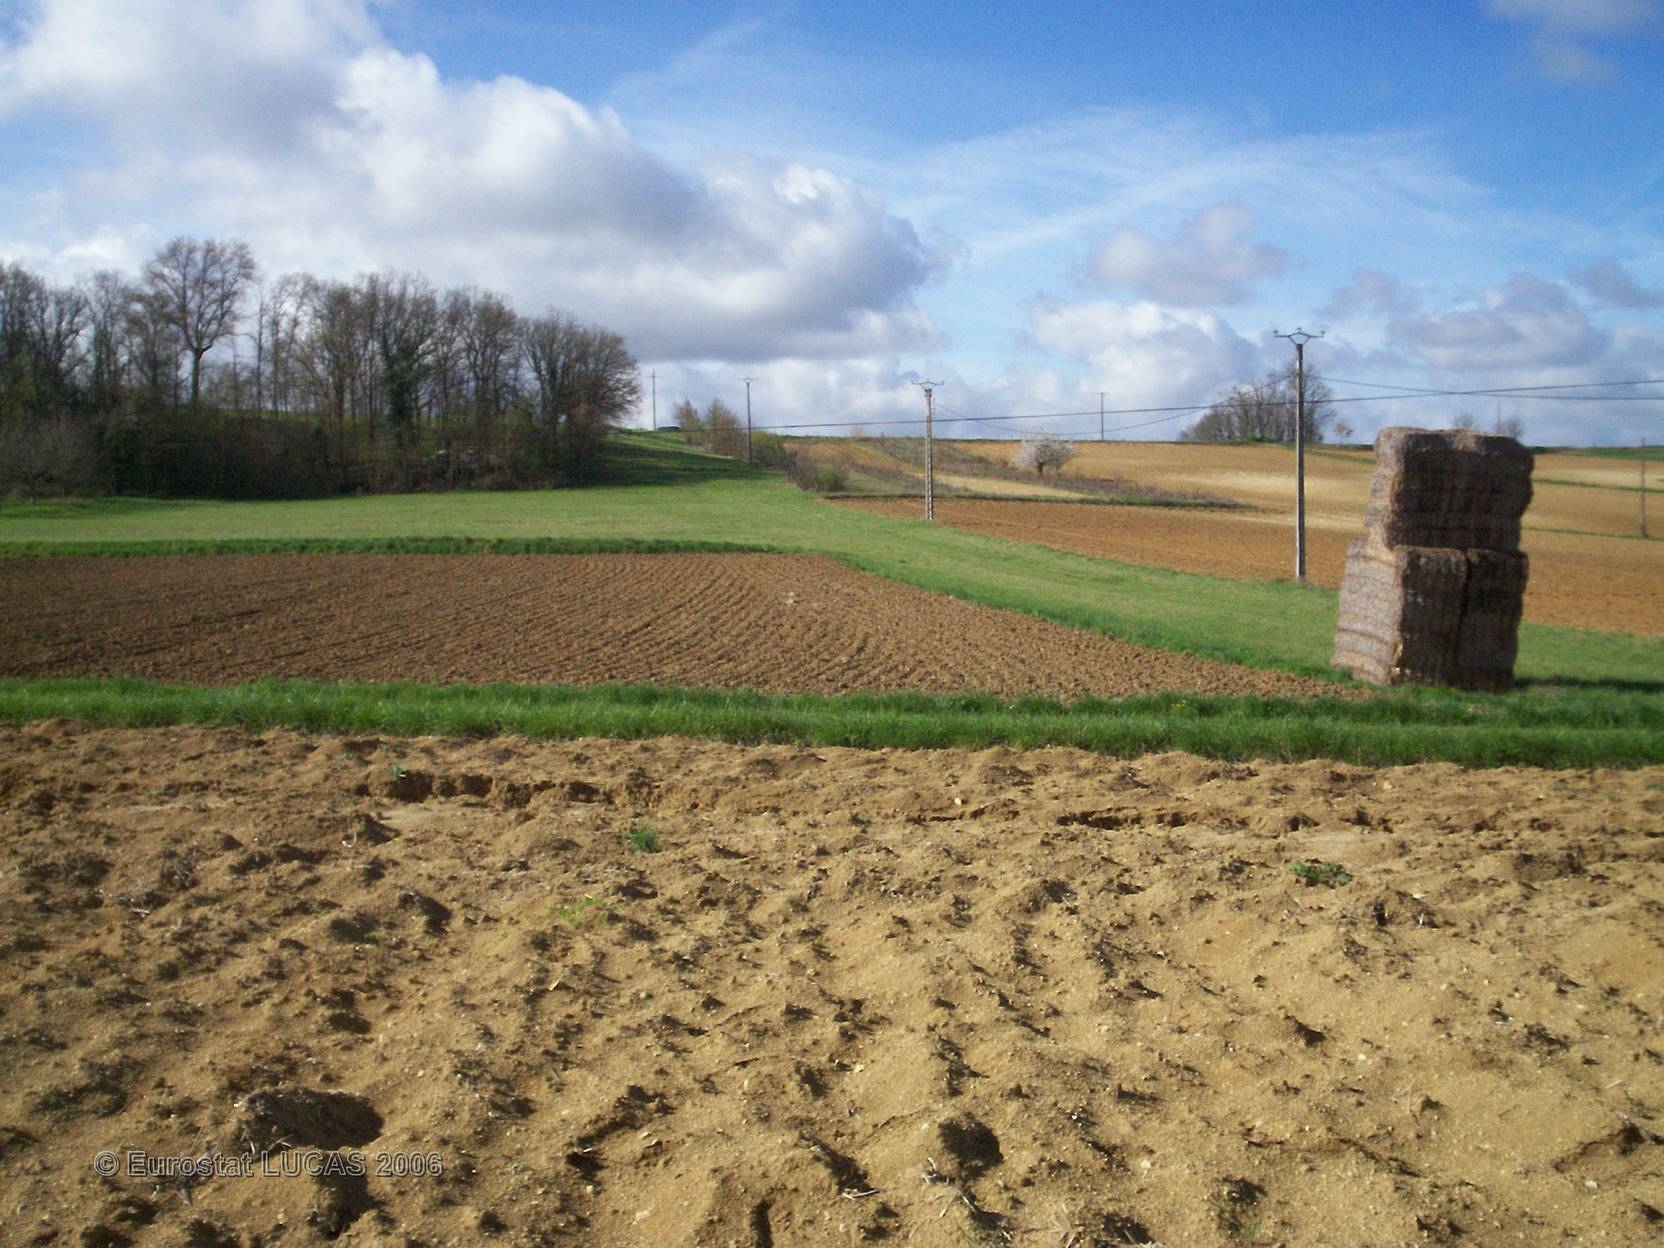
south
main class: Cropland
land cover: Sunflower
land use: Agriculture (excluding fallow land and kitchen gardens)
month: June
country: FR
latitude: 44.1838
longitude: 0.8769
